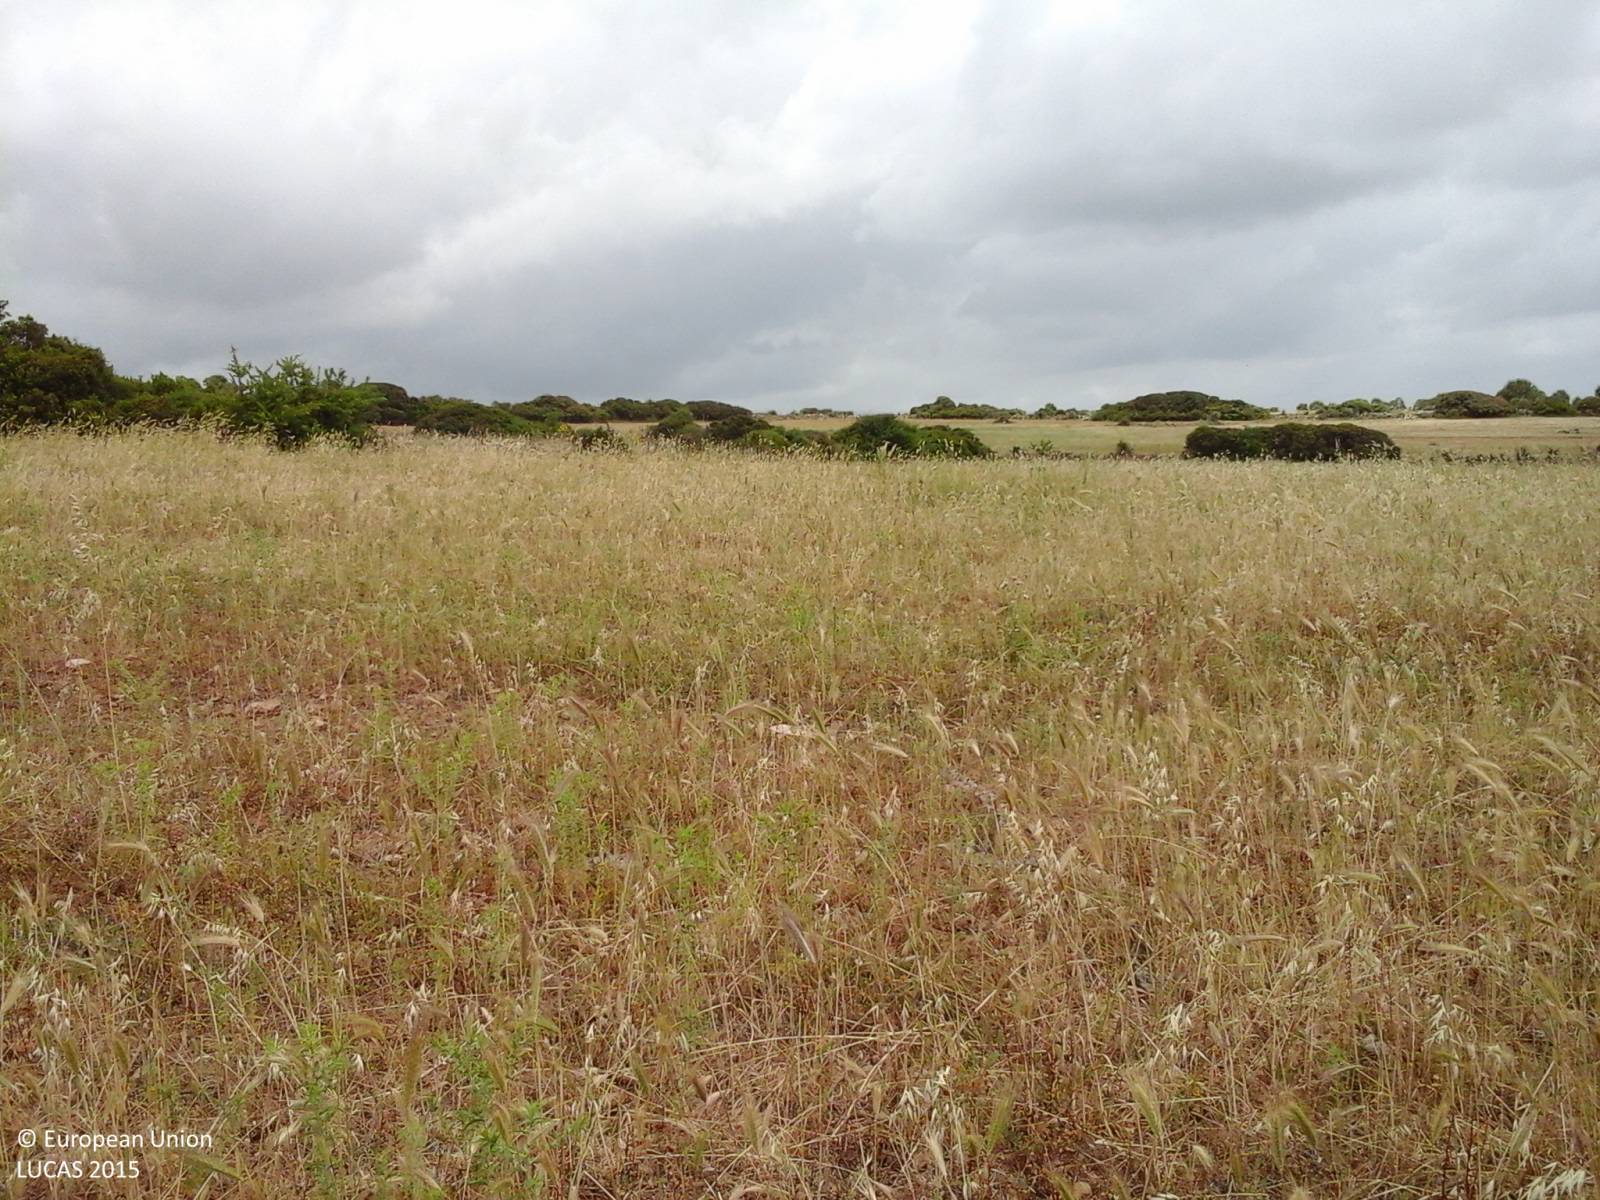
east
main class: Grassland
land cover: Spontaneously vegetated surfaces
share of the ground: > 75 %
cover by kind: herbaceous plants 100 %
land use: Agriculture (excluding fallow land and kitchen gardens)
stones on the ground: 25 - 50 %
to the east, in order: Spontaneously vegetated surfaces; Dry stone walls; Fences; Managed hedges; Spontaneously vegetated surfaces; Dry stone walls; Fences; Managed hedges; Spontaneously vegetated surfaces; Fences; Dry stone walls
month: May
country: IT
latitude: 39.8625
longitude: 8.8724
